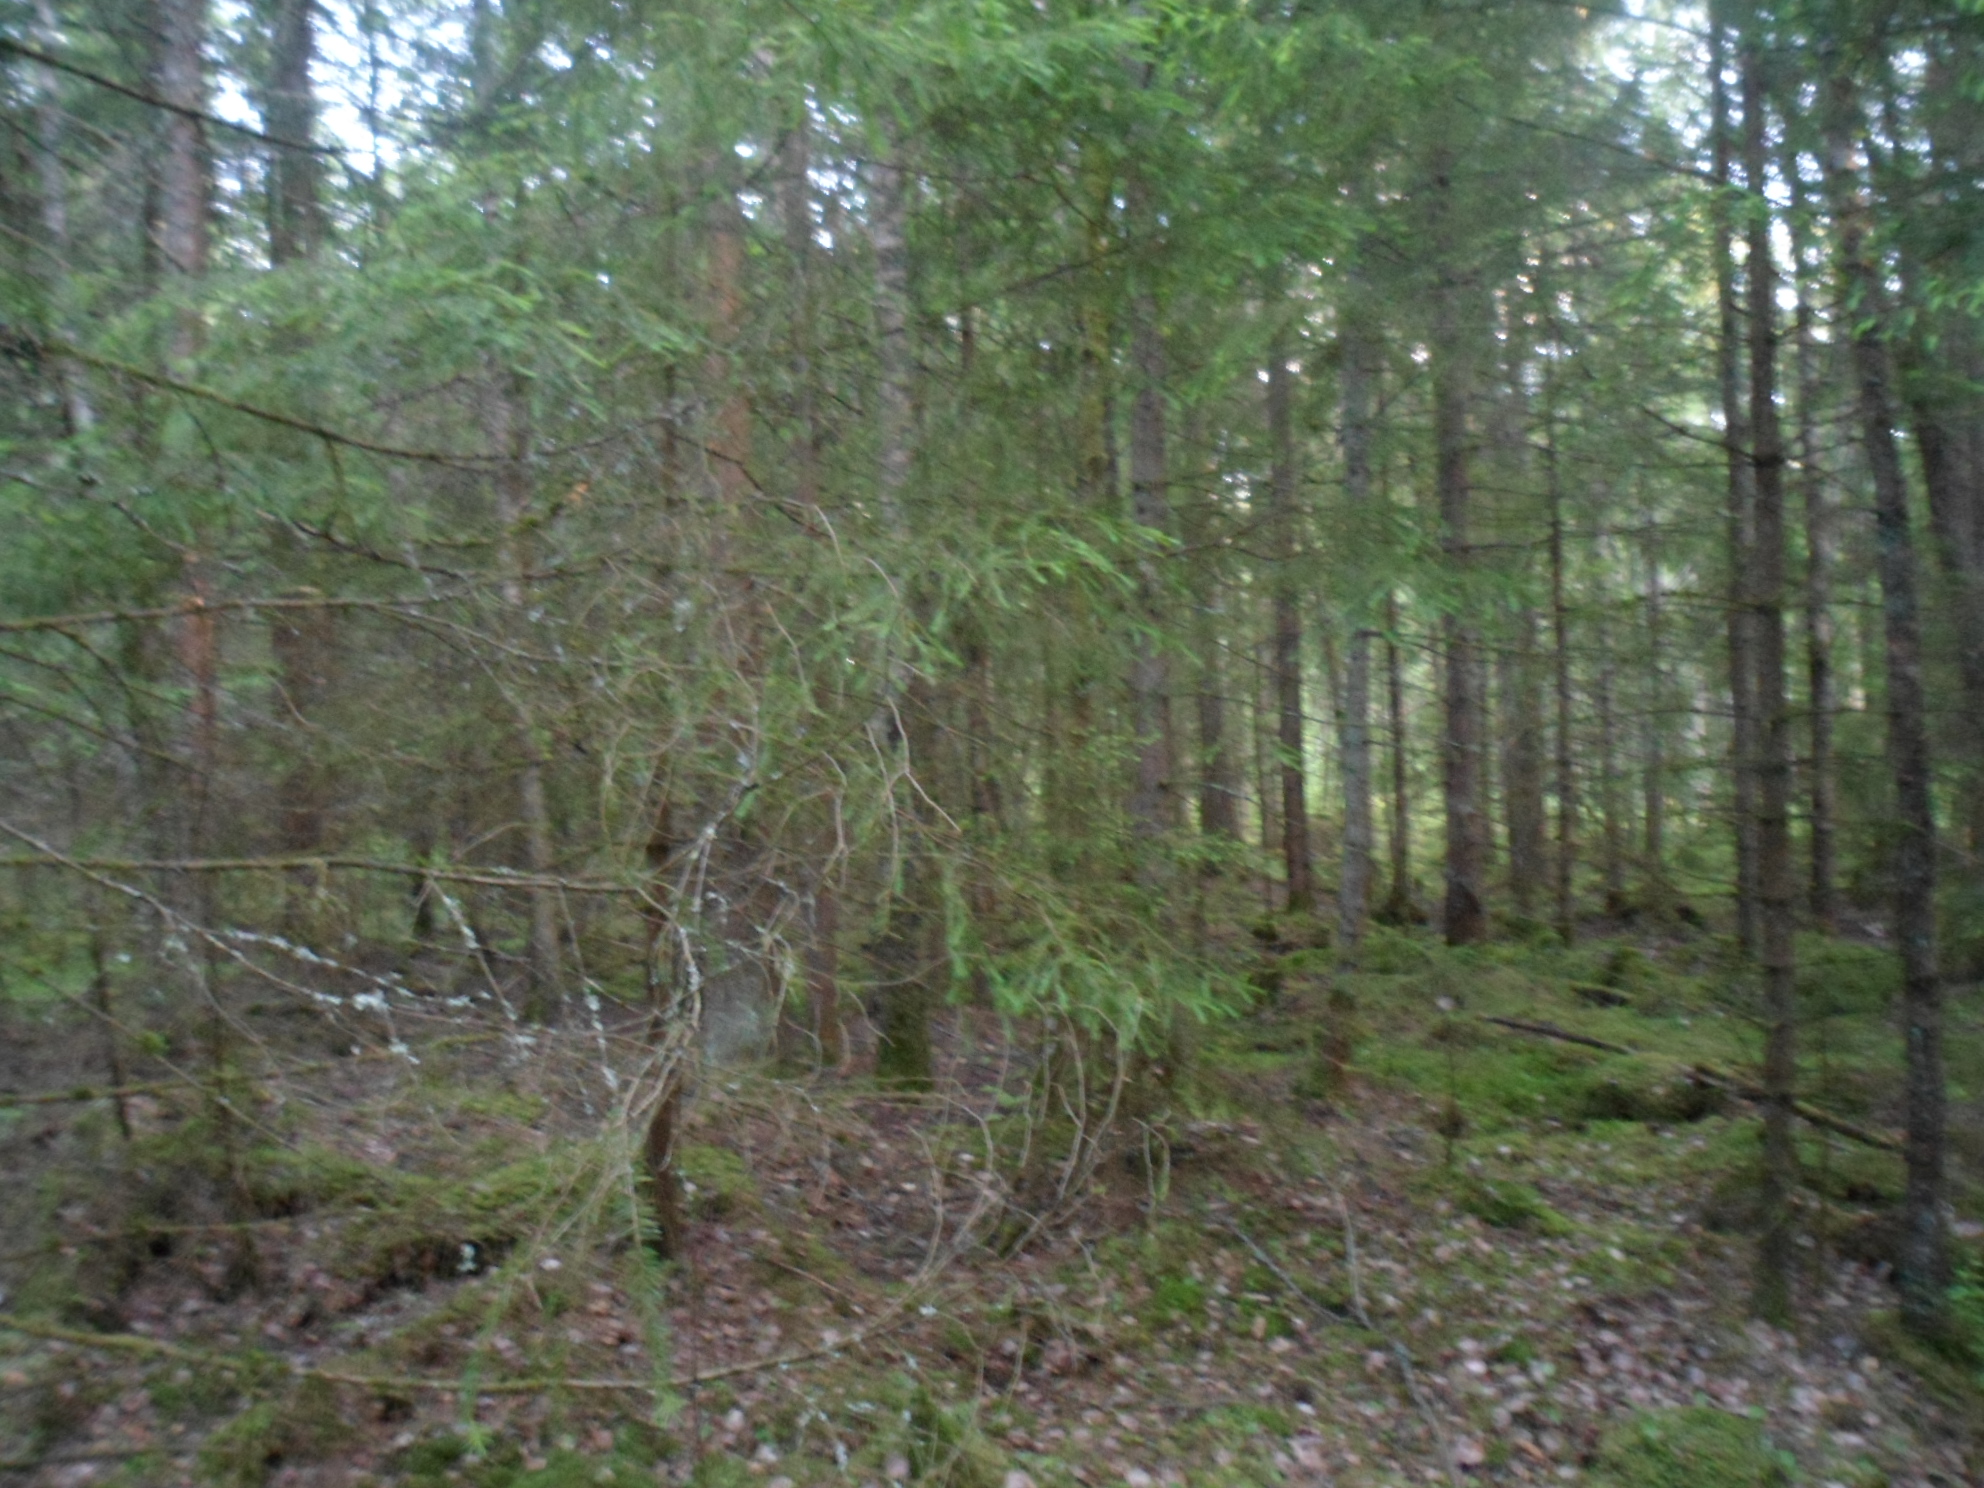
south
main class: Woodland
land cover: Spruce dominated mixed woodland
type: boreal forest
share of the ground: > 75 %
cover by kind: coniferous forest trees 50 %, broadleaved forest trees 30 %, lichens and mosses 15 %, herbaceous plants 5 %
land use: Forestry
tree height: > 5 m
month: June
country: SE
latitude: 57.2776
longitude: 14.5574
